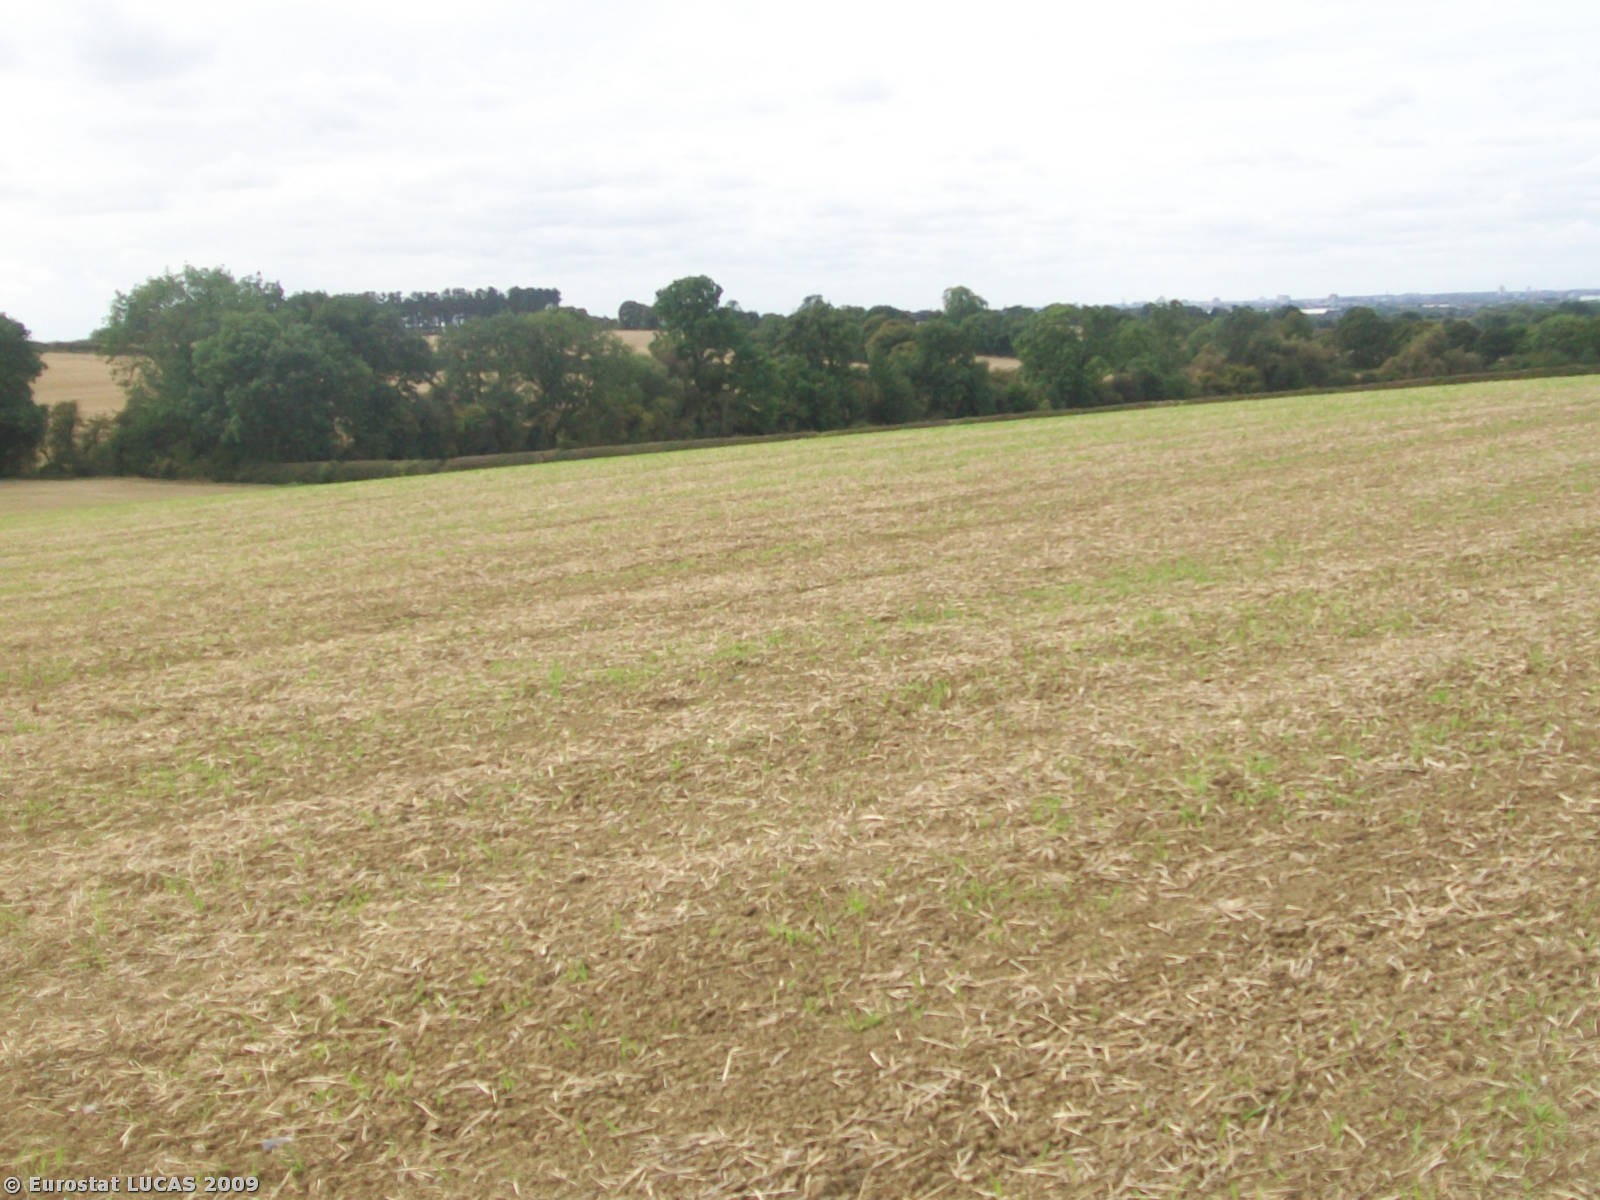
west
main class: Cropland
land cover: Common wheat
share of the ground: < 10 %
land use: Agriculture (excluding fallow land and kitchen gardens)
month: September
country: GB
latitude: 52.4473
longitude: -1.3635
